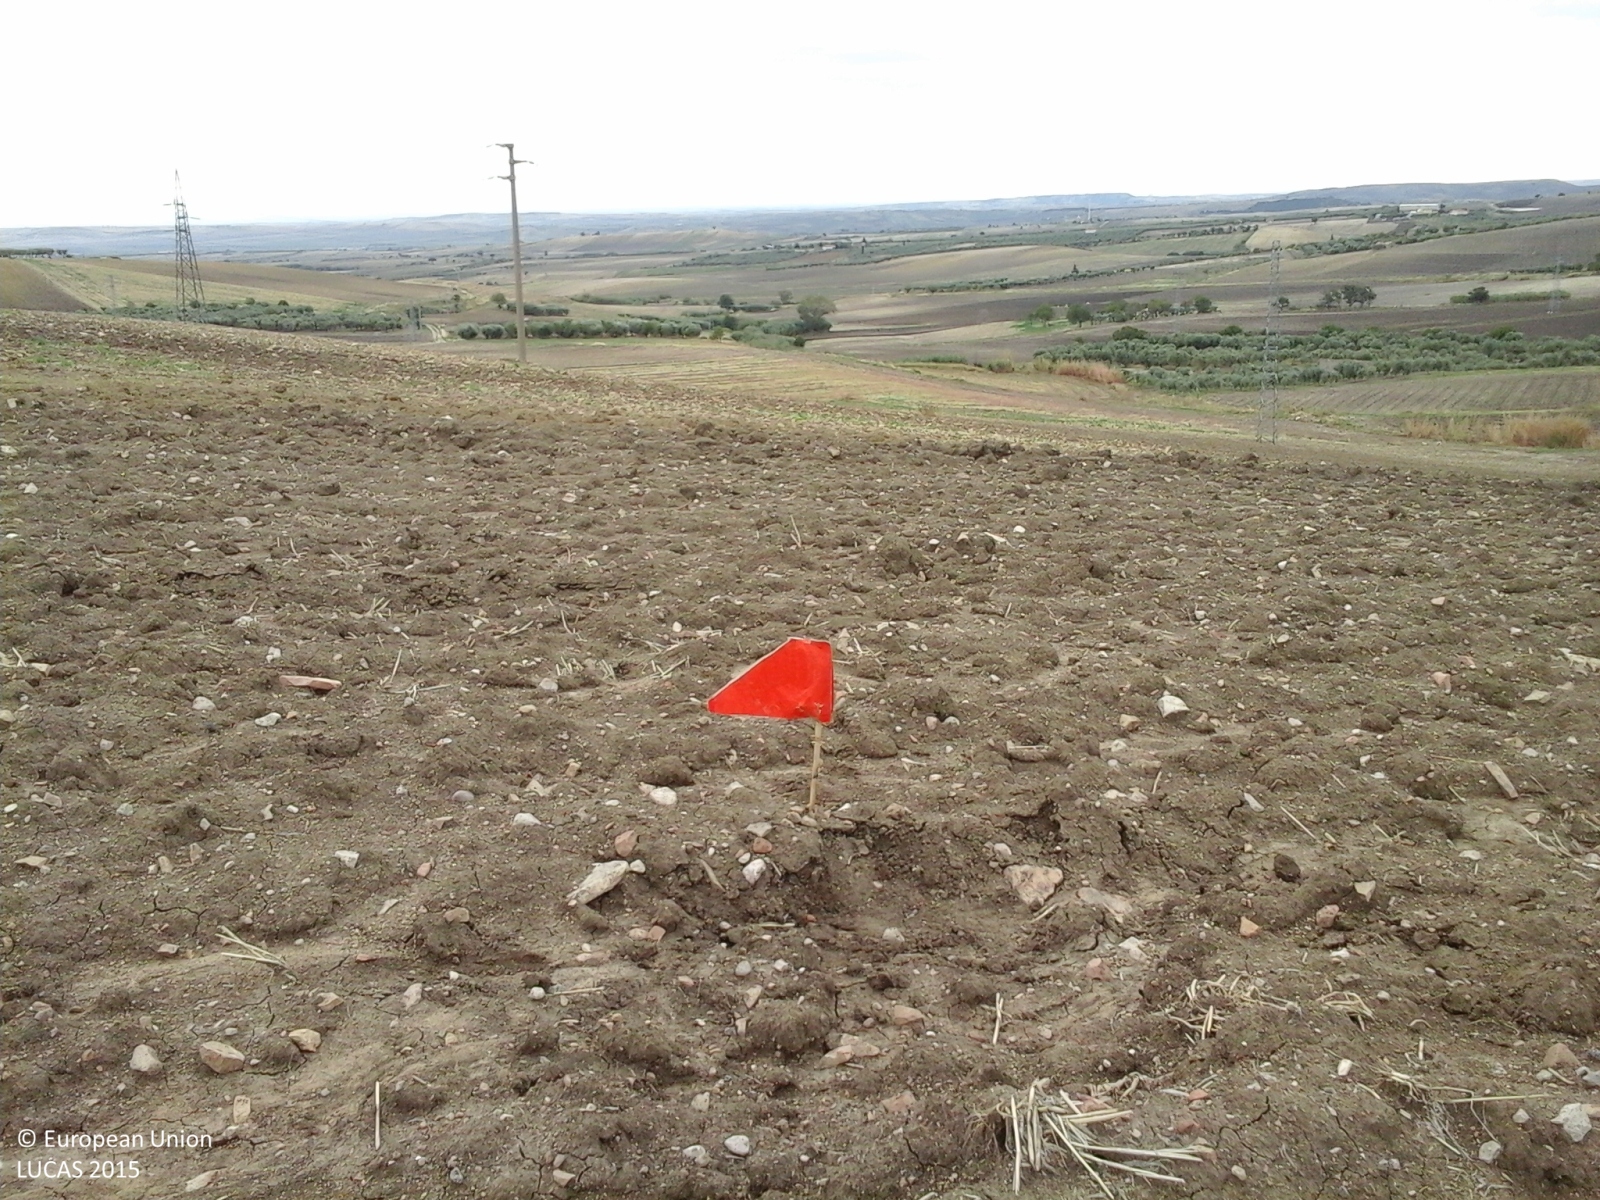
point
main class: Cropland
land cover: Barley
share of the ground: > 75 %
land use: Agriculture (excluding fallow land and kitchen gardens)
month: October
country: IT
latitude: 41.6009
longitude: 15.1303
